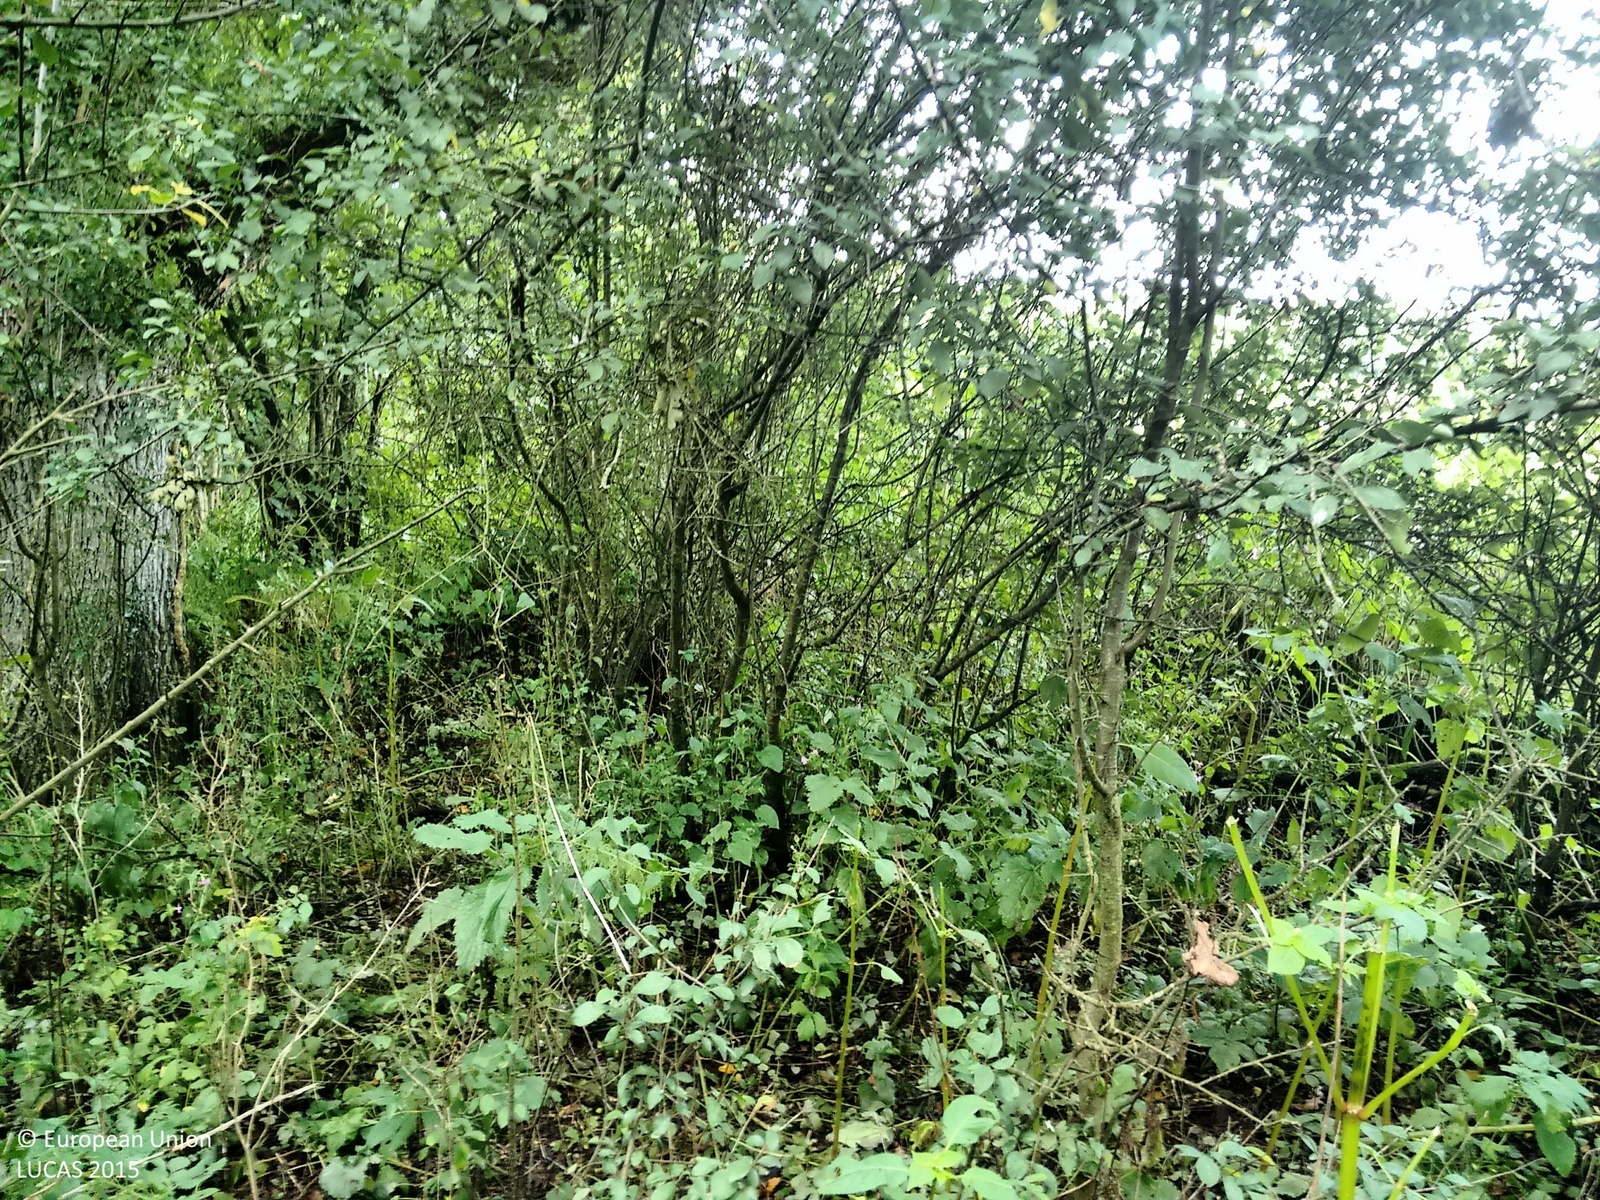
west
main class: Woodland
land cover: Broadleaved woodland
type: mesophytic deciduous forest
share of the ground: > 75 %
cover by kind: broadleaved forest trees 100 %
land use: Semi-natural and natural areas not in use
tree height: > 5 m
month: September
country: GB
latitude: 50.7613
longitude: -4.4072
